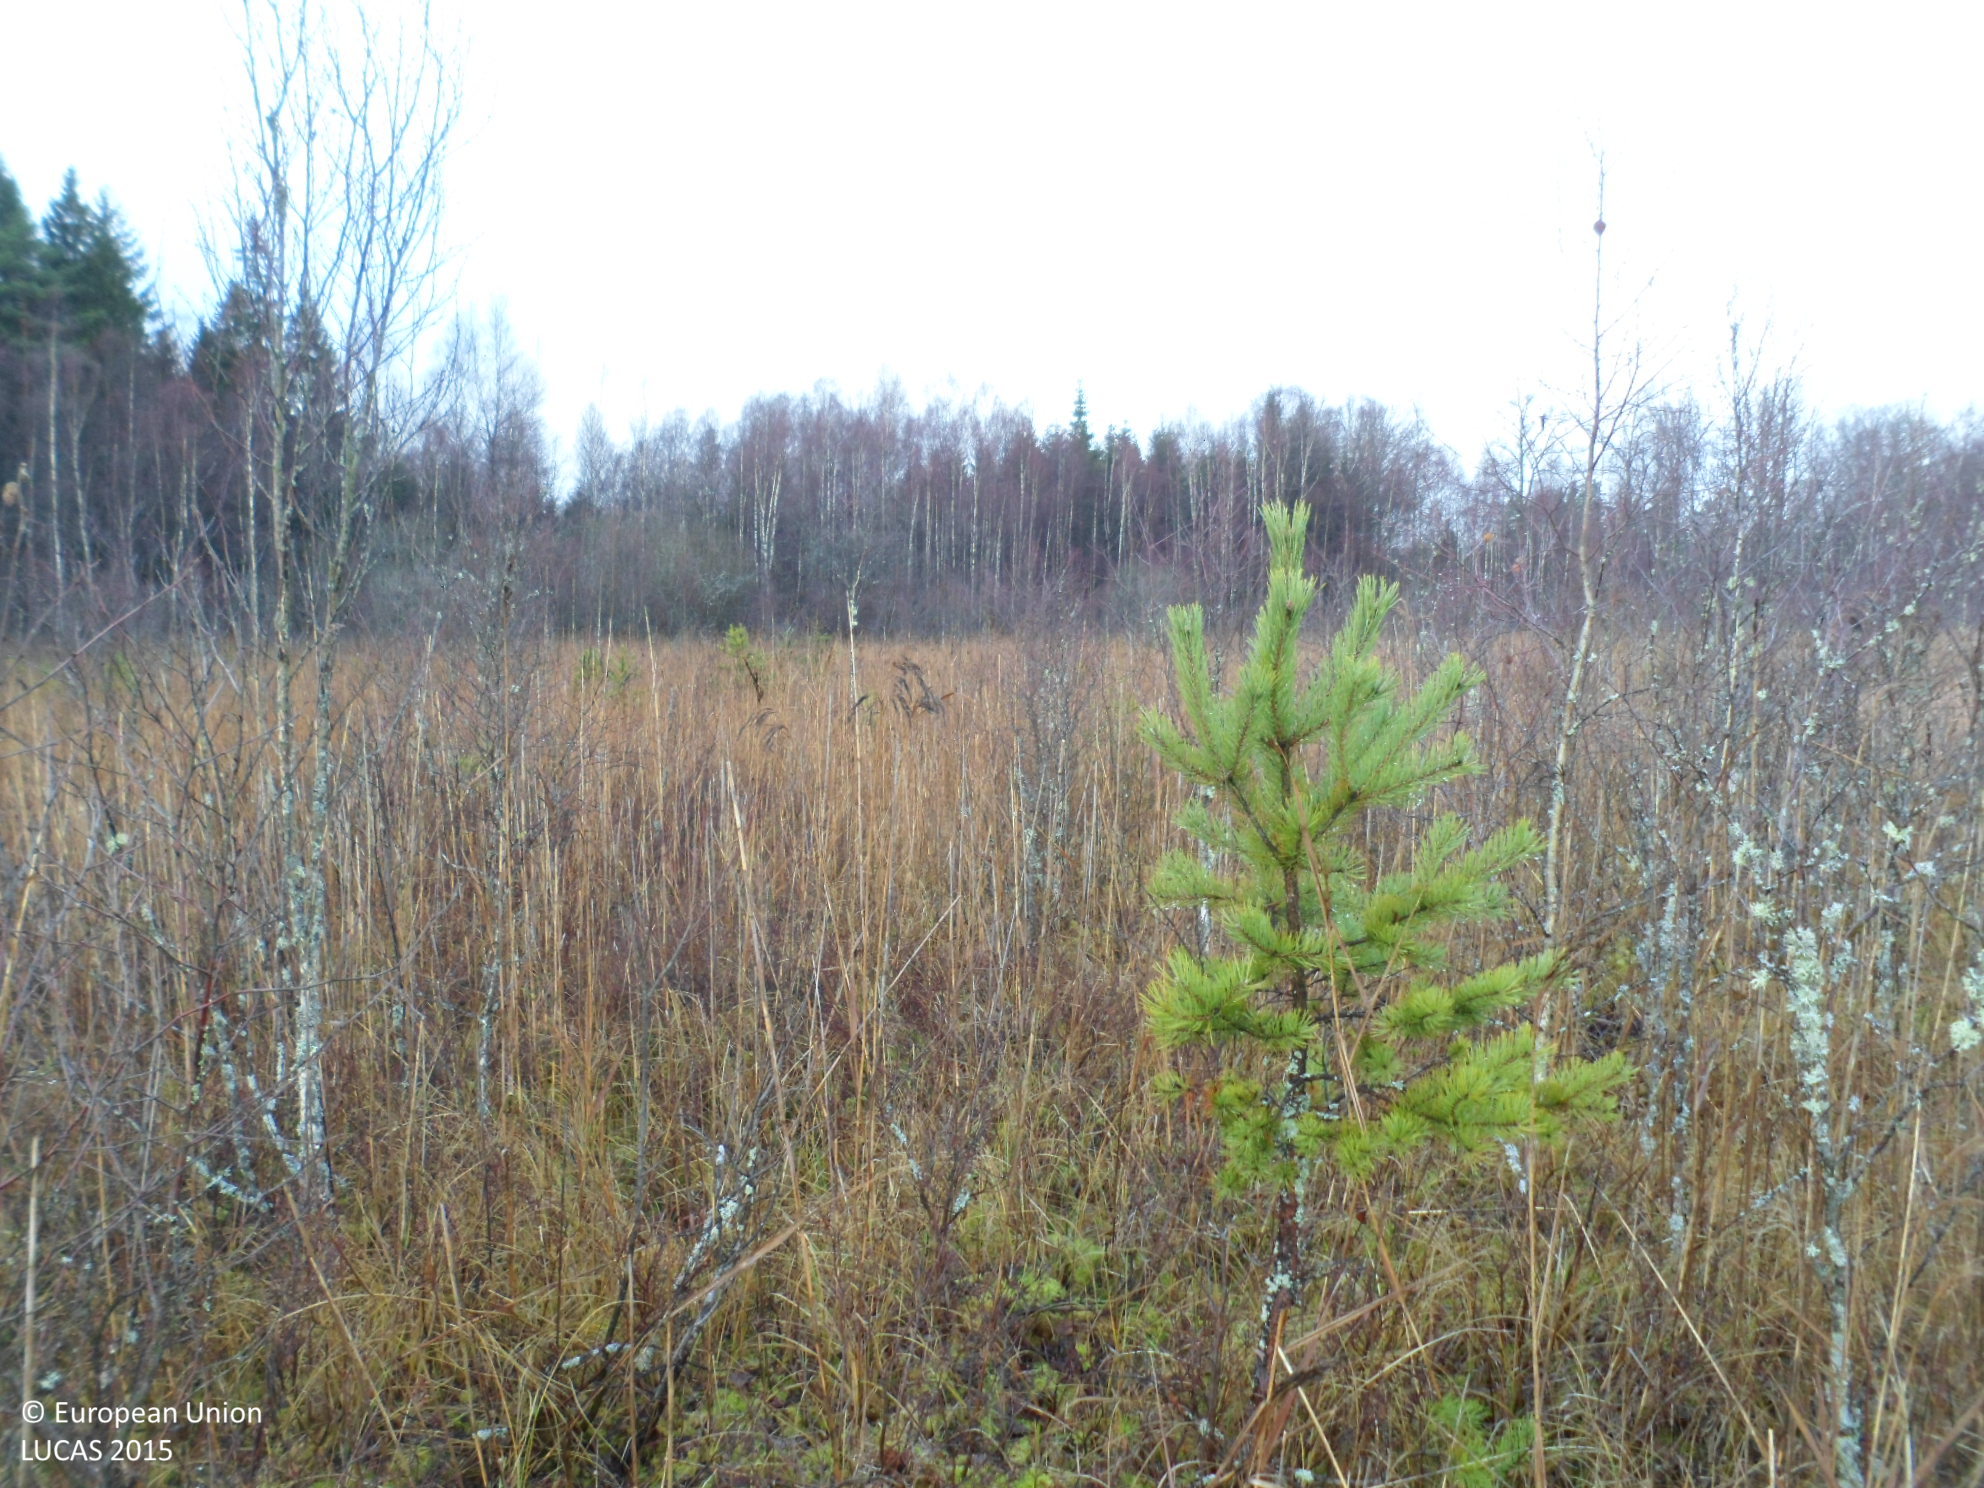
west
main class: Woodland
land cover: Pine dominated mixed woodland
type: mire and swamp forests
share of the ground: 10 - 25 %
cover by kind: lichens and mosses 40 %, herbaceous plants 30 %, coniferous forest trees 10 %, broadleaved forest trees 10 %, shrubs 10 %
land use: Semi-natural and natural areas not in use
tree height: < 5 m
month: November
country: SE
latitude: 57.5625
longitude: 15.9986
